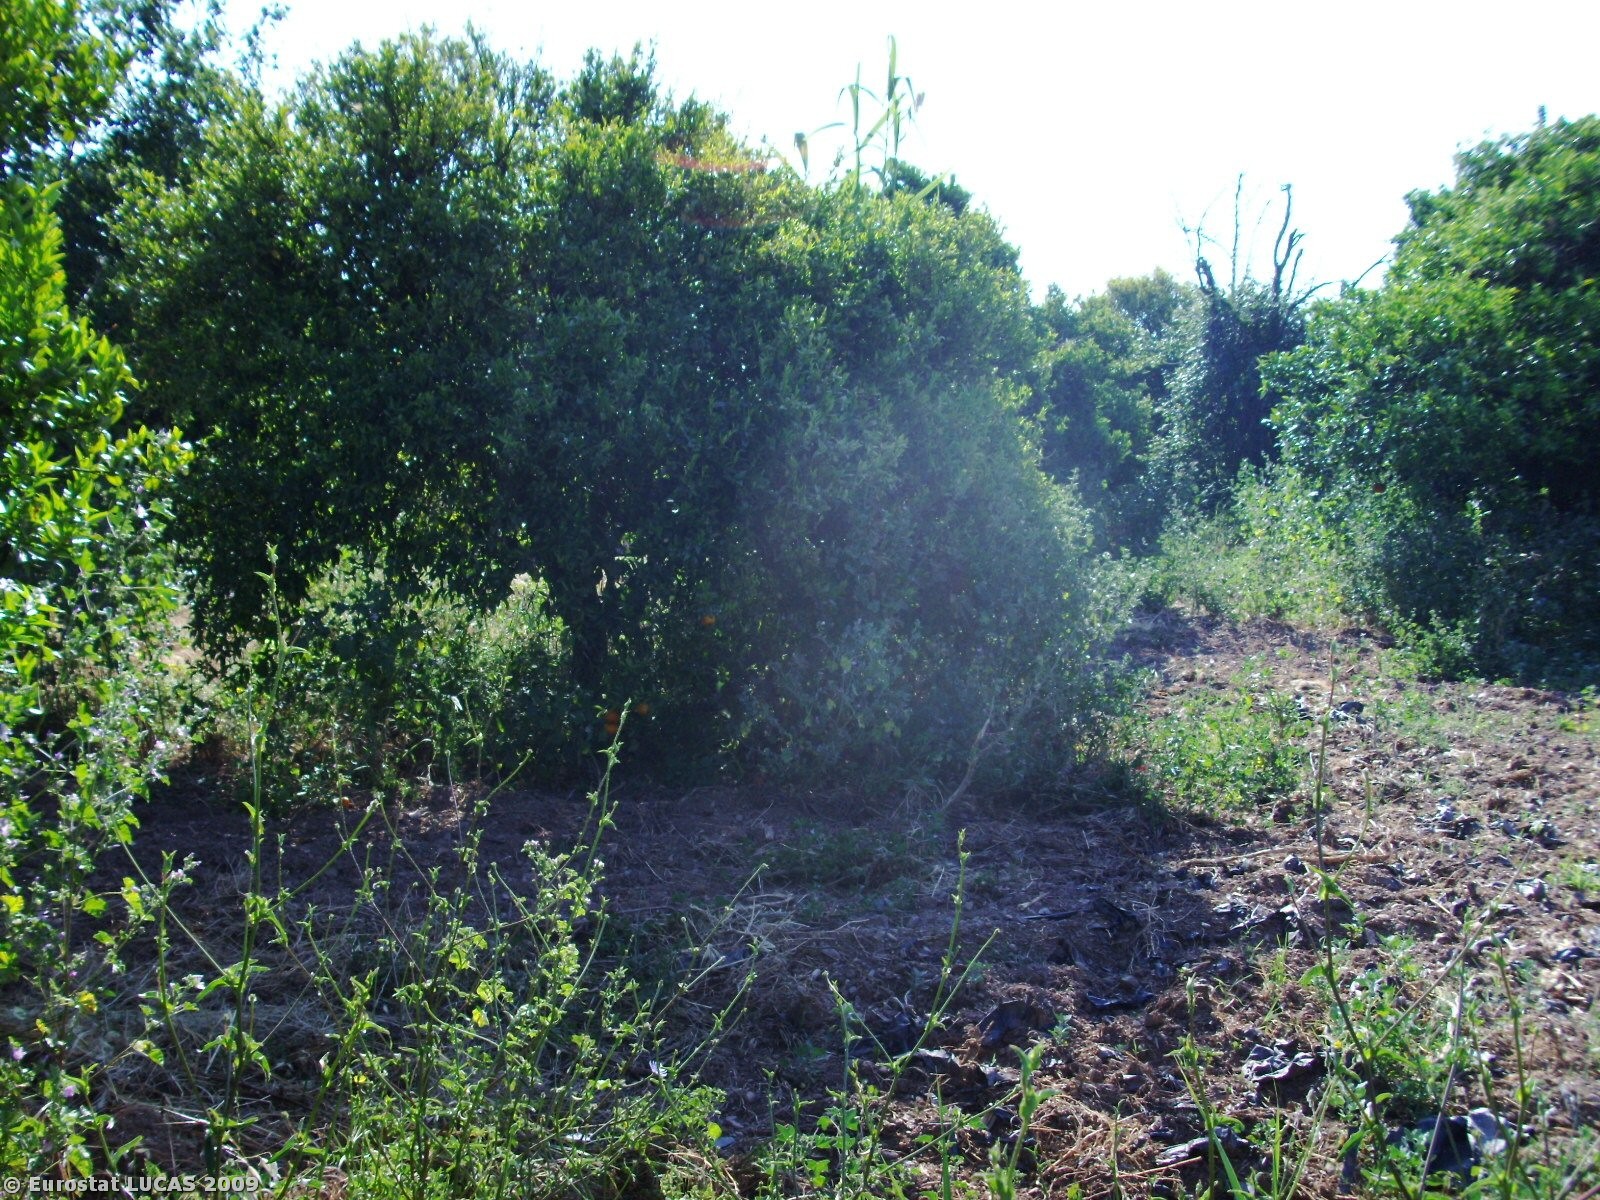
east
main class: Cropland
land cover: Oranges
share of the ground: 50 - 75 %
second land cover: Spontaneously vegetated surfaces
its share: 10 - 25 %
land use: Agriculture (excluding fallow land and kitchen gardens)
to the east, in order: Oranges; Spontaneously vegetated surfaces; Oranges; Tracks; Oranges; Fences; Potatoes; Fences; Oranges; Fences; Oranges; Fences; Spontaneously vegetated surfaces
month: May
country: PT
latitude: 37.2634
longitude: -7.4703
